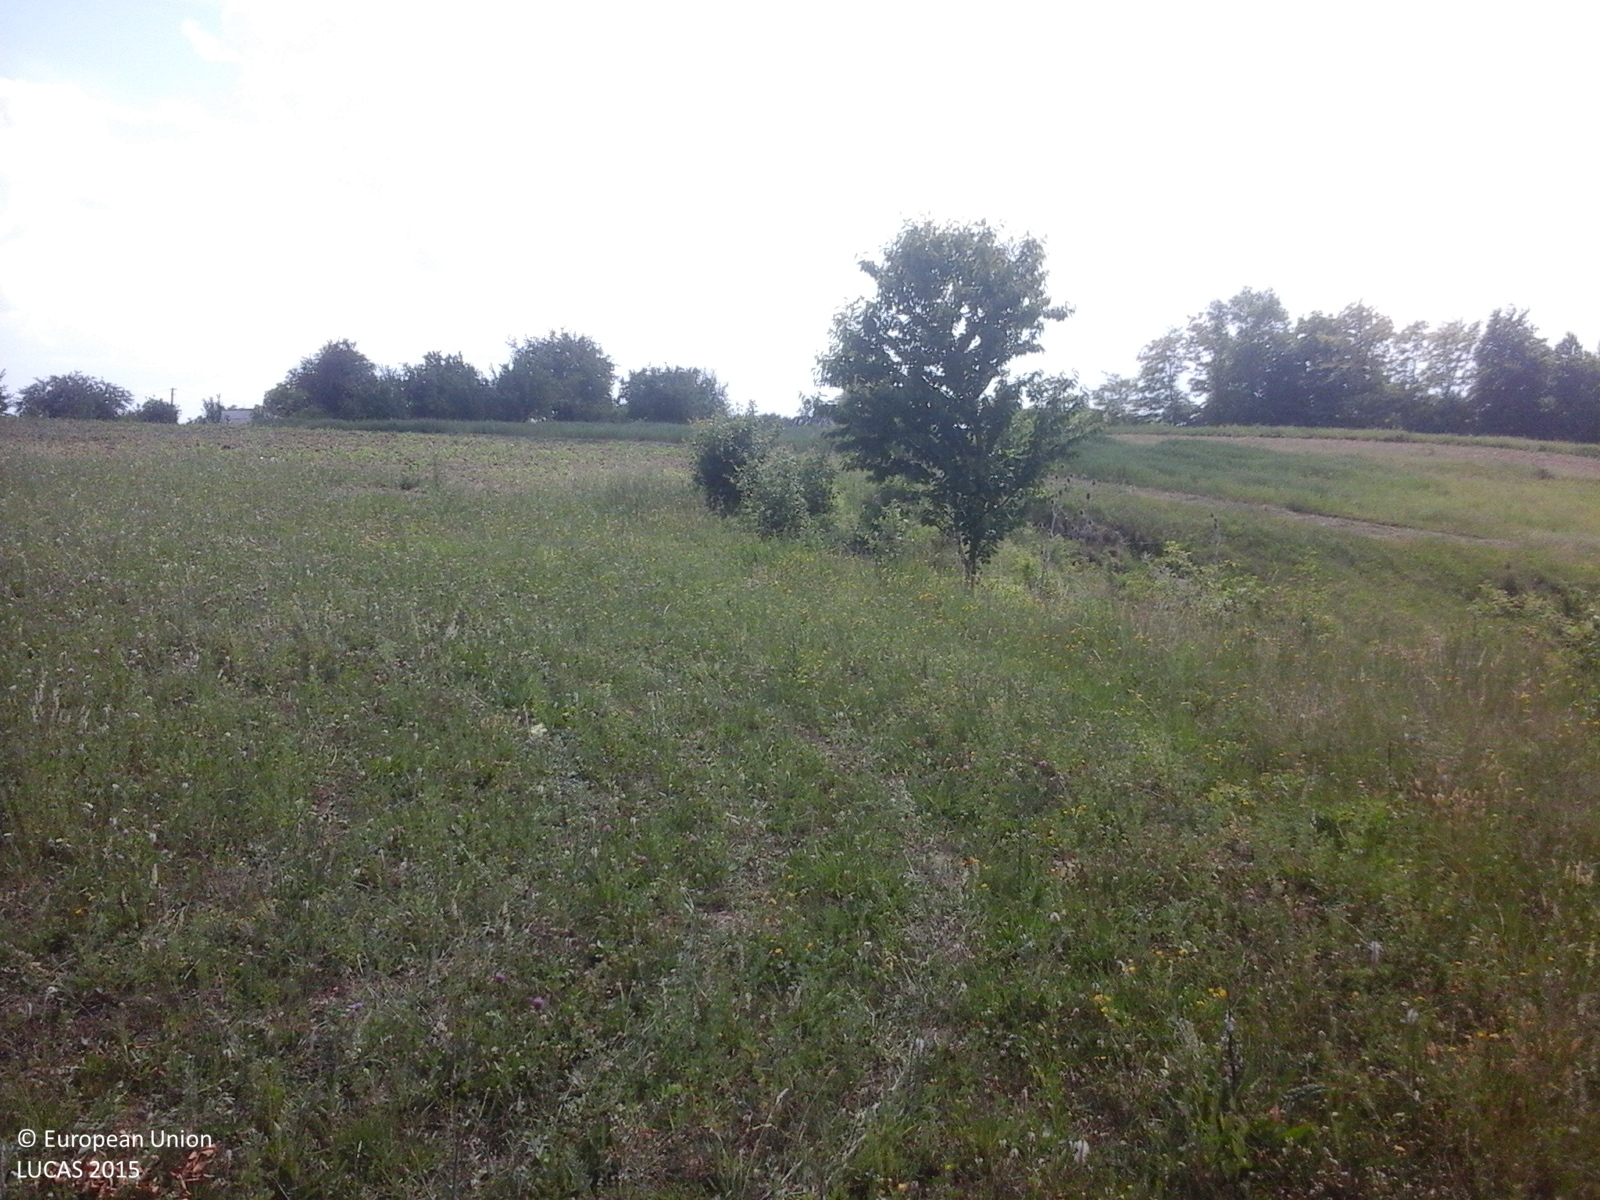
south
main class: Grassland
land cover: Grassland with sparse tree/shrub cover
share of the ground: > 75 %
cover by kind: herbaceous plants 85 %, shrubs 10 %, broadleaved forest trees 5 %
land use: Agriculture (excluding fallow land and kitchen gardens)
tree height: < 5 m
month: June
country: RO
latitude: 46.5410
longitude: 26.7679
